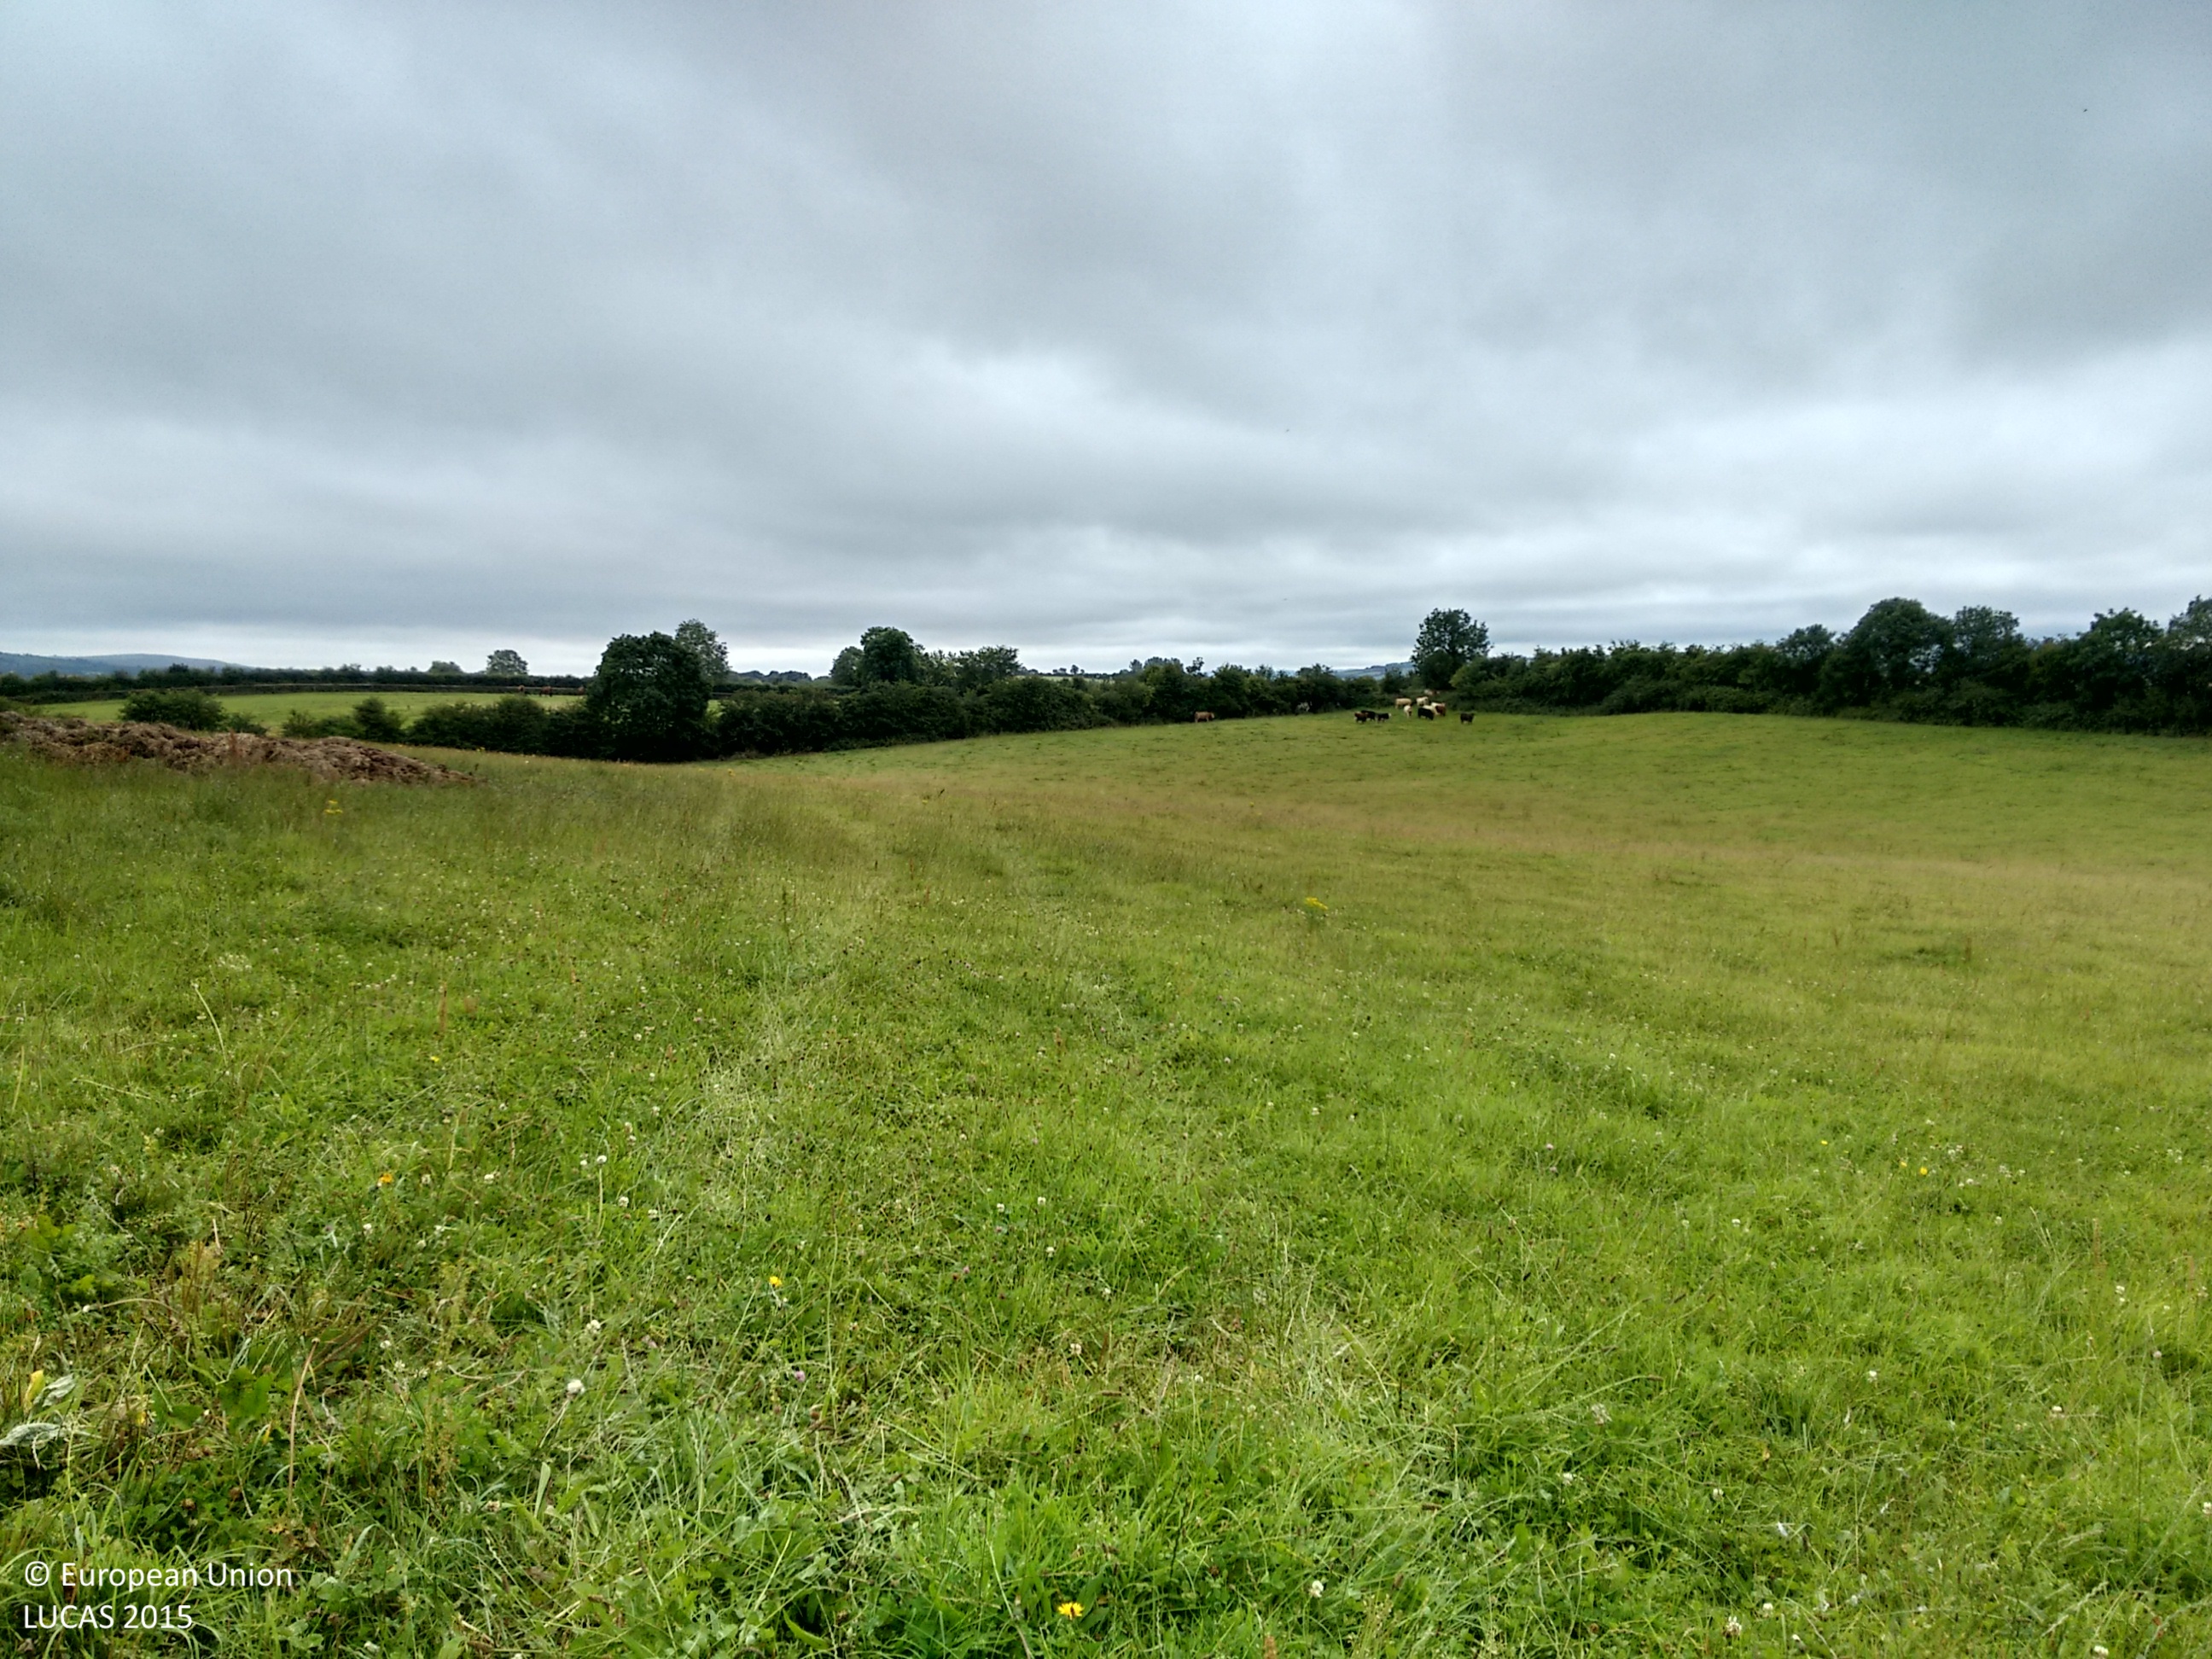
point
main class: Grassland
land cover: Grassland without tree/shrub cover
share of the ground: > 75 %
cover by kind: herbaceous plants 100 %
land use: Agriculture (excluding fallow land and kitchen gardens)
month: August
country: IE
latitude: 52.8729
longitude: -7.3431
